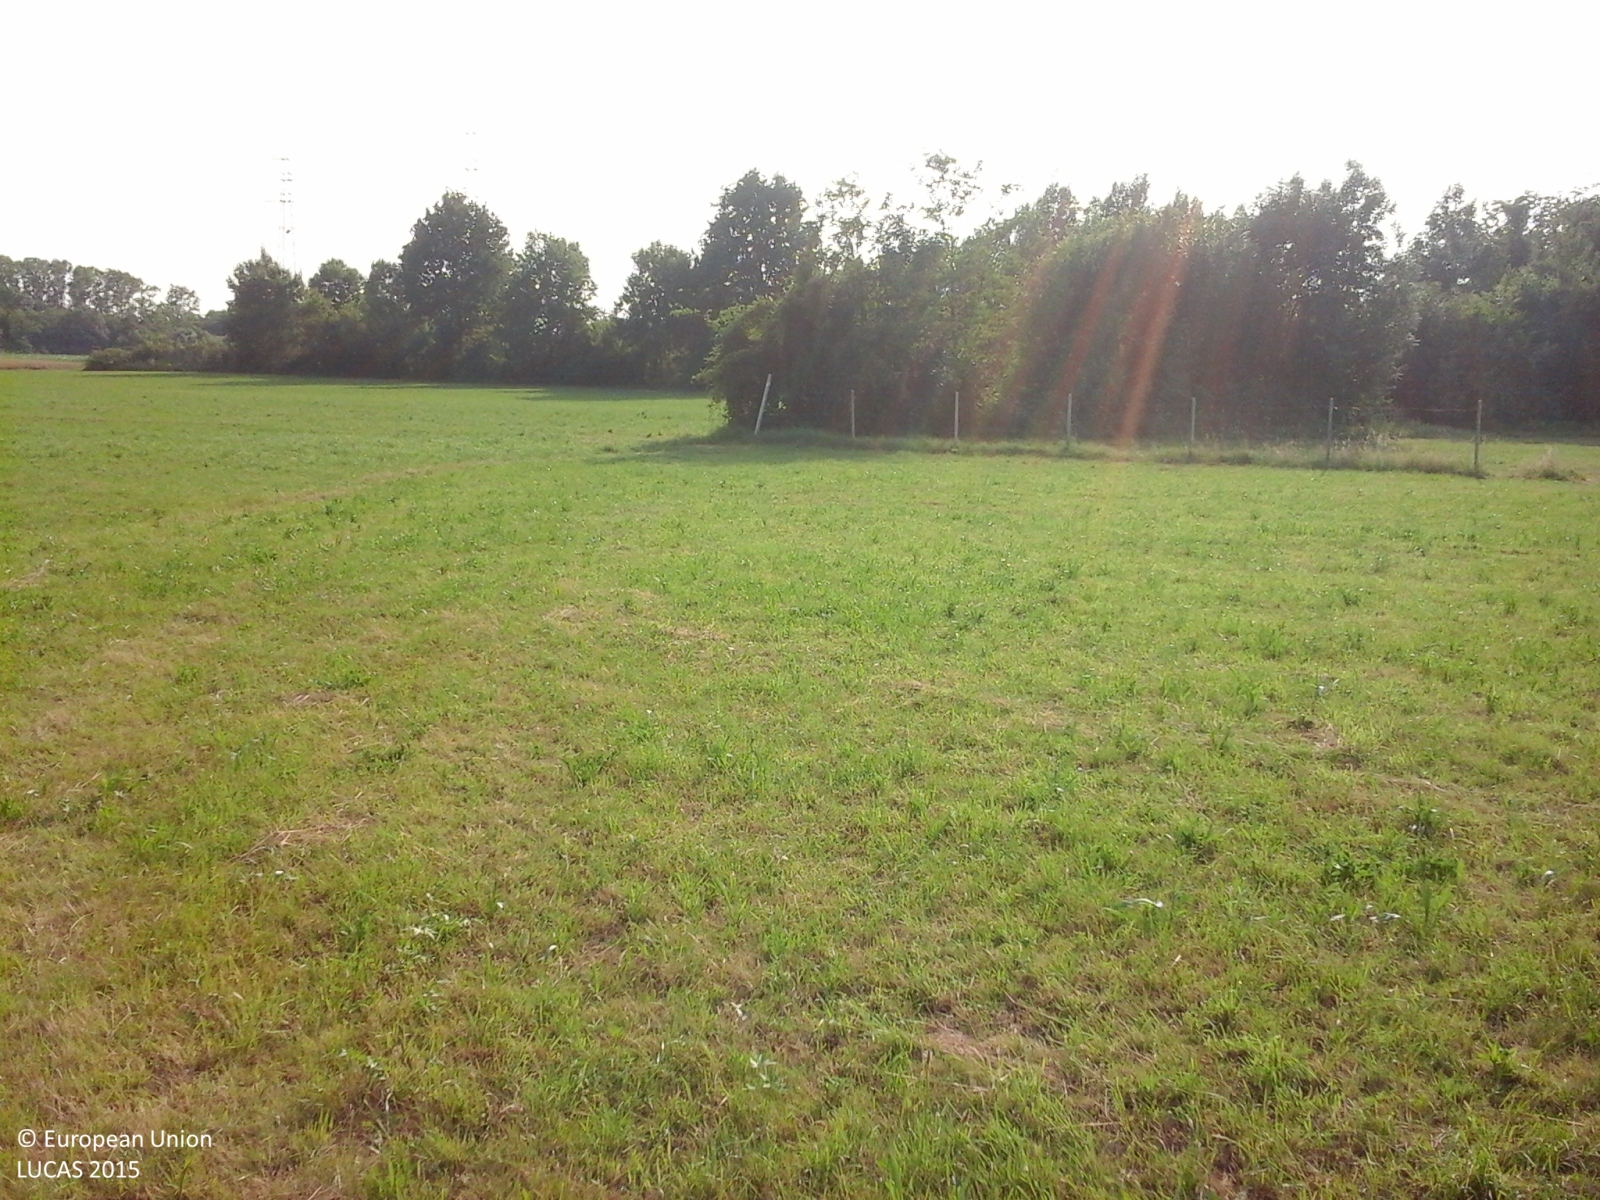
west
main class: Grassland
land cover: Grassland without tree/shrub cover
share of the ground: > 75 %
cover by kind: herbaceous plants 100 %
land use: Agriculture (excluding fallow land and kitchen gardens)
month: June
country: IT
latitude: 45.2100
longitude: 7.7502
